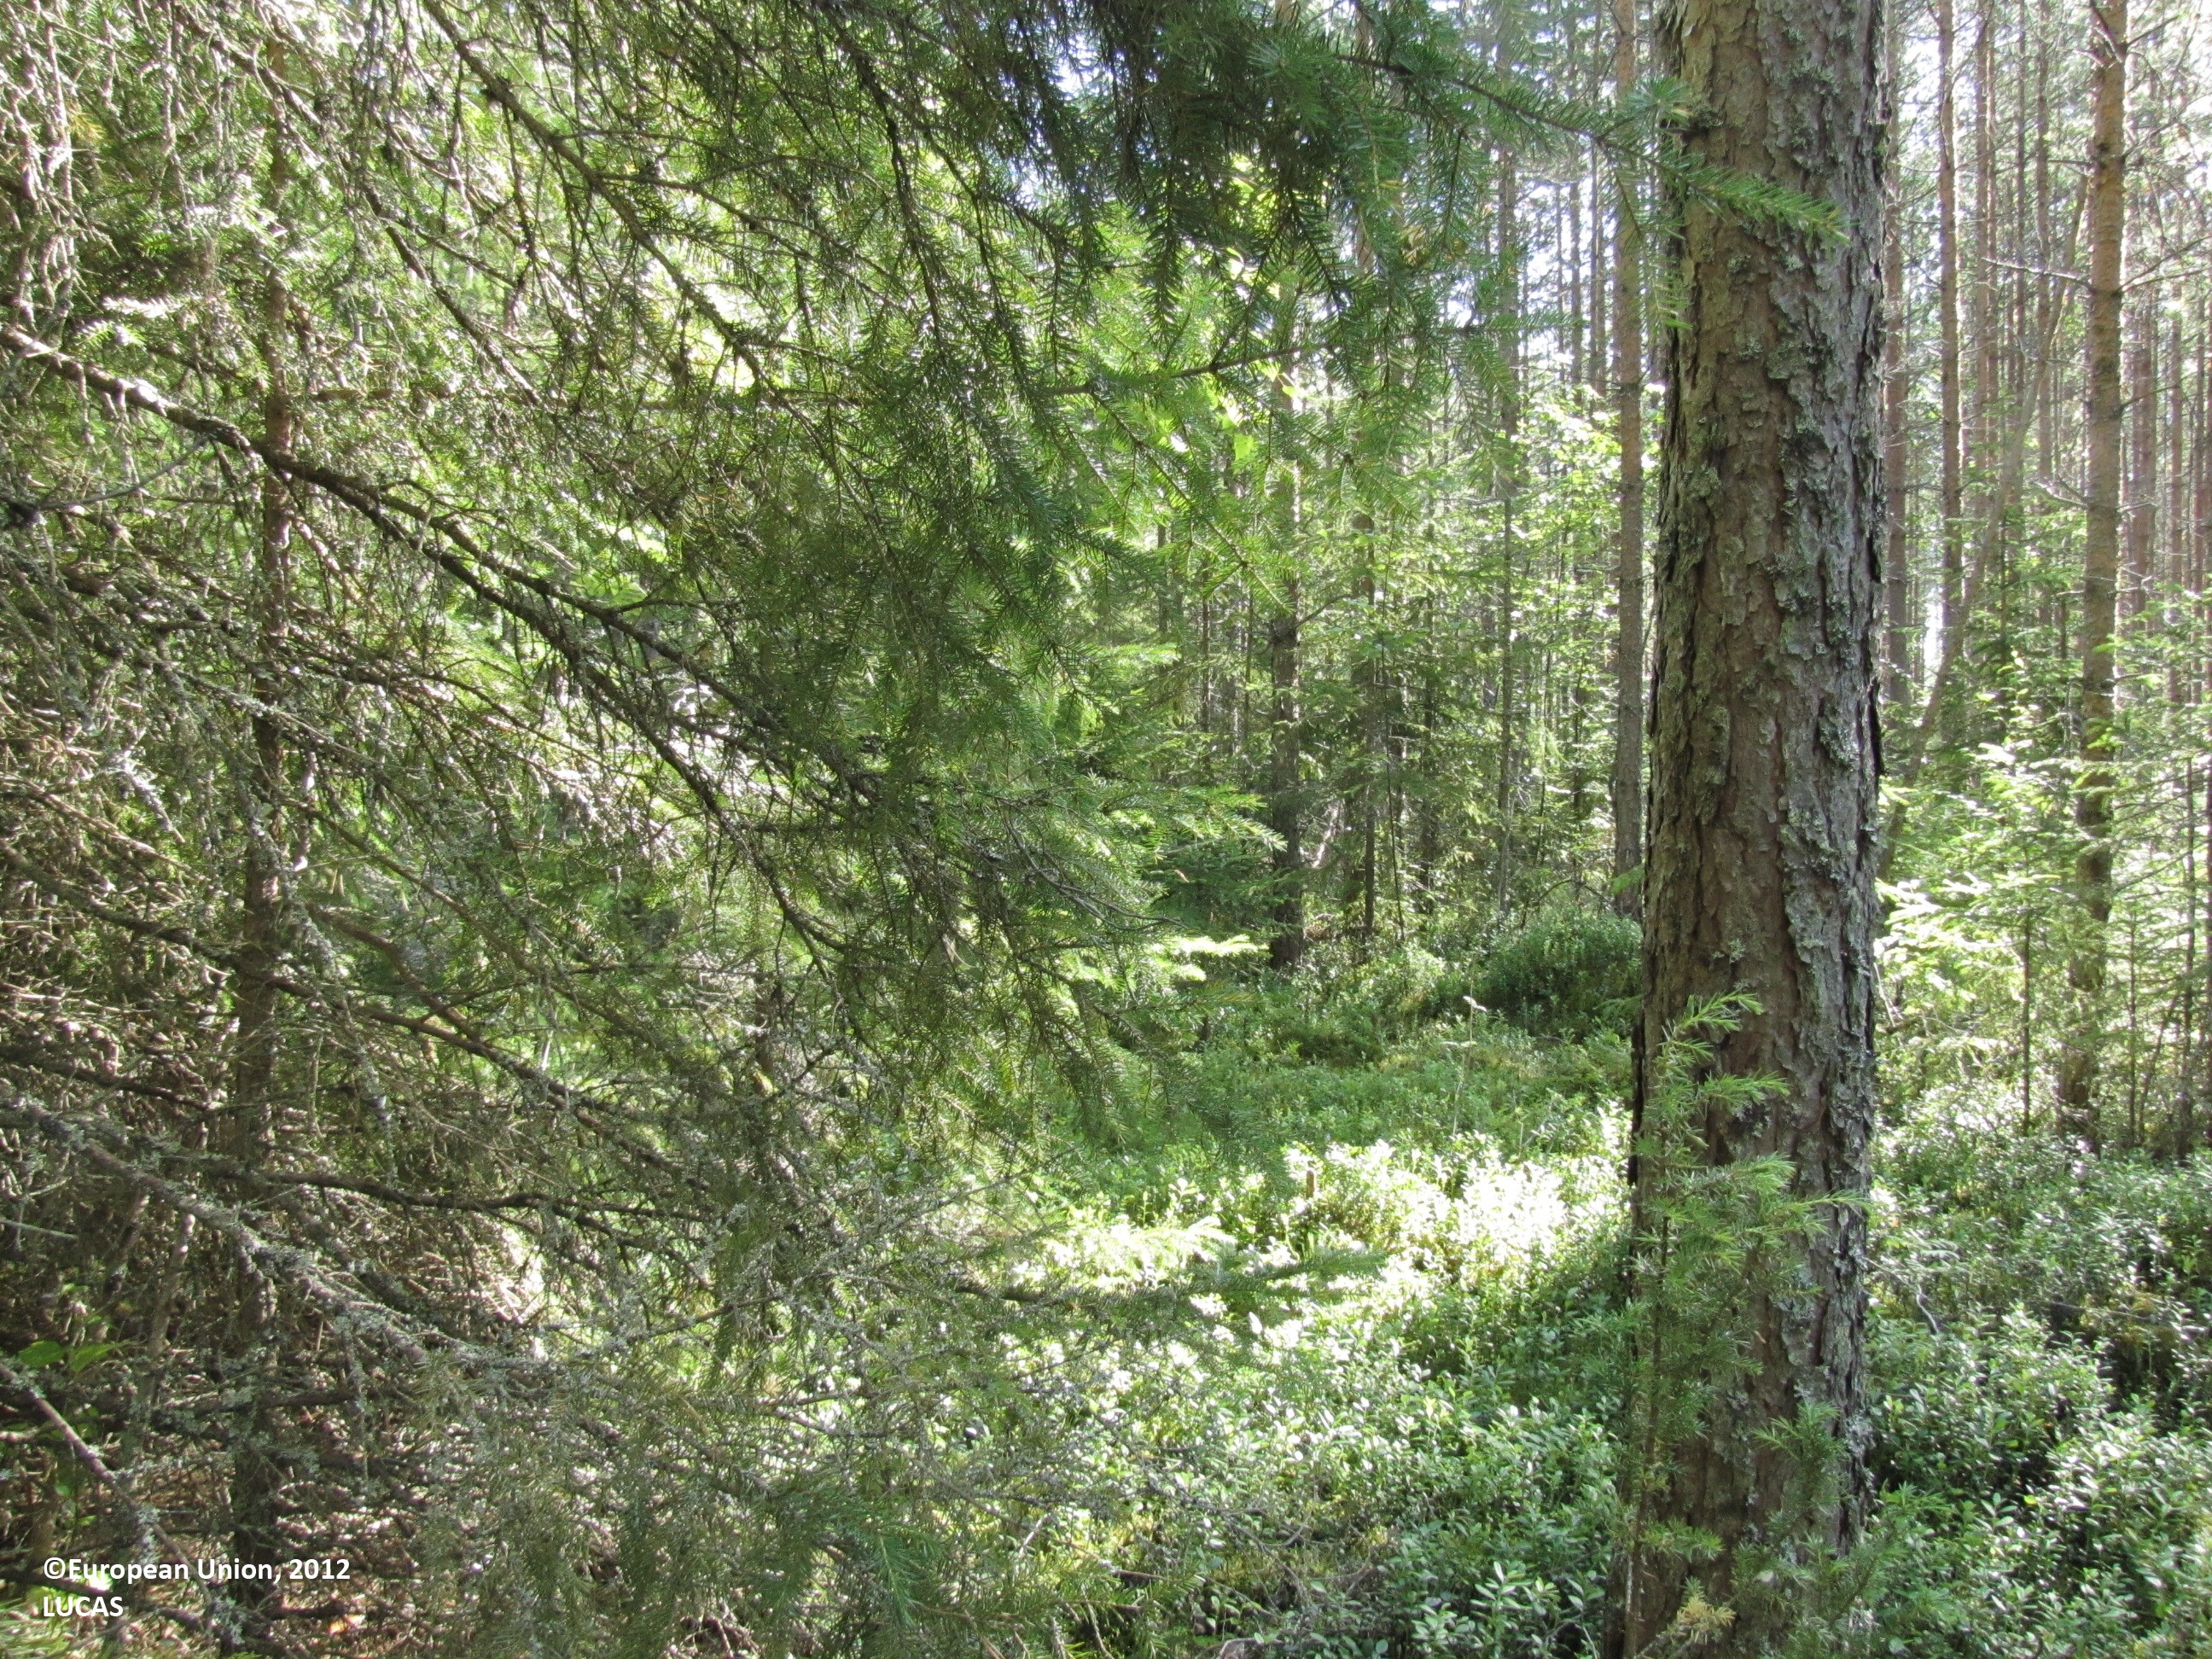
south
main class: Woodland
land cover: Pine dominated coniferous woodland
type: boreal forest
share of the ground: > 75 %
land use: Forestry
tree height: > 5 m
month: July
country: FI
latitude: 62.3515
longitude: 23.0654
